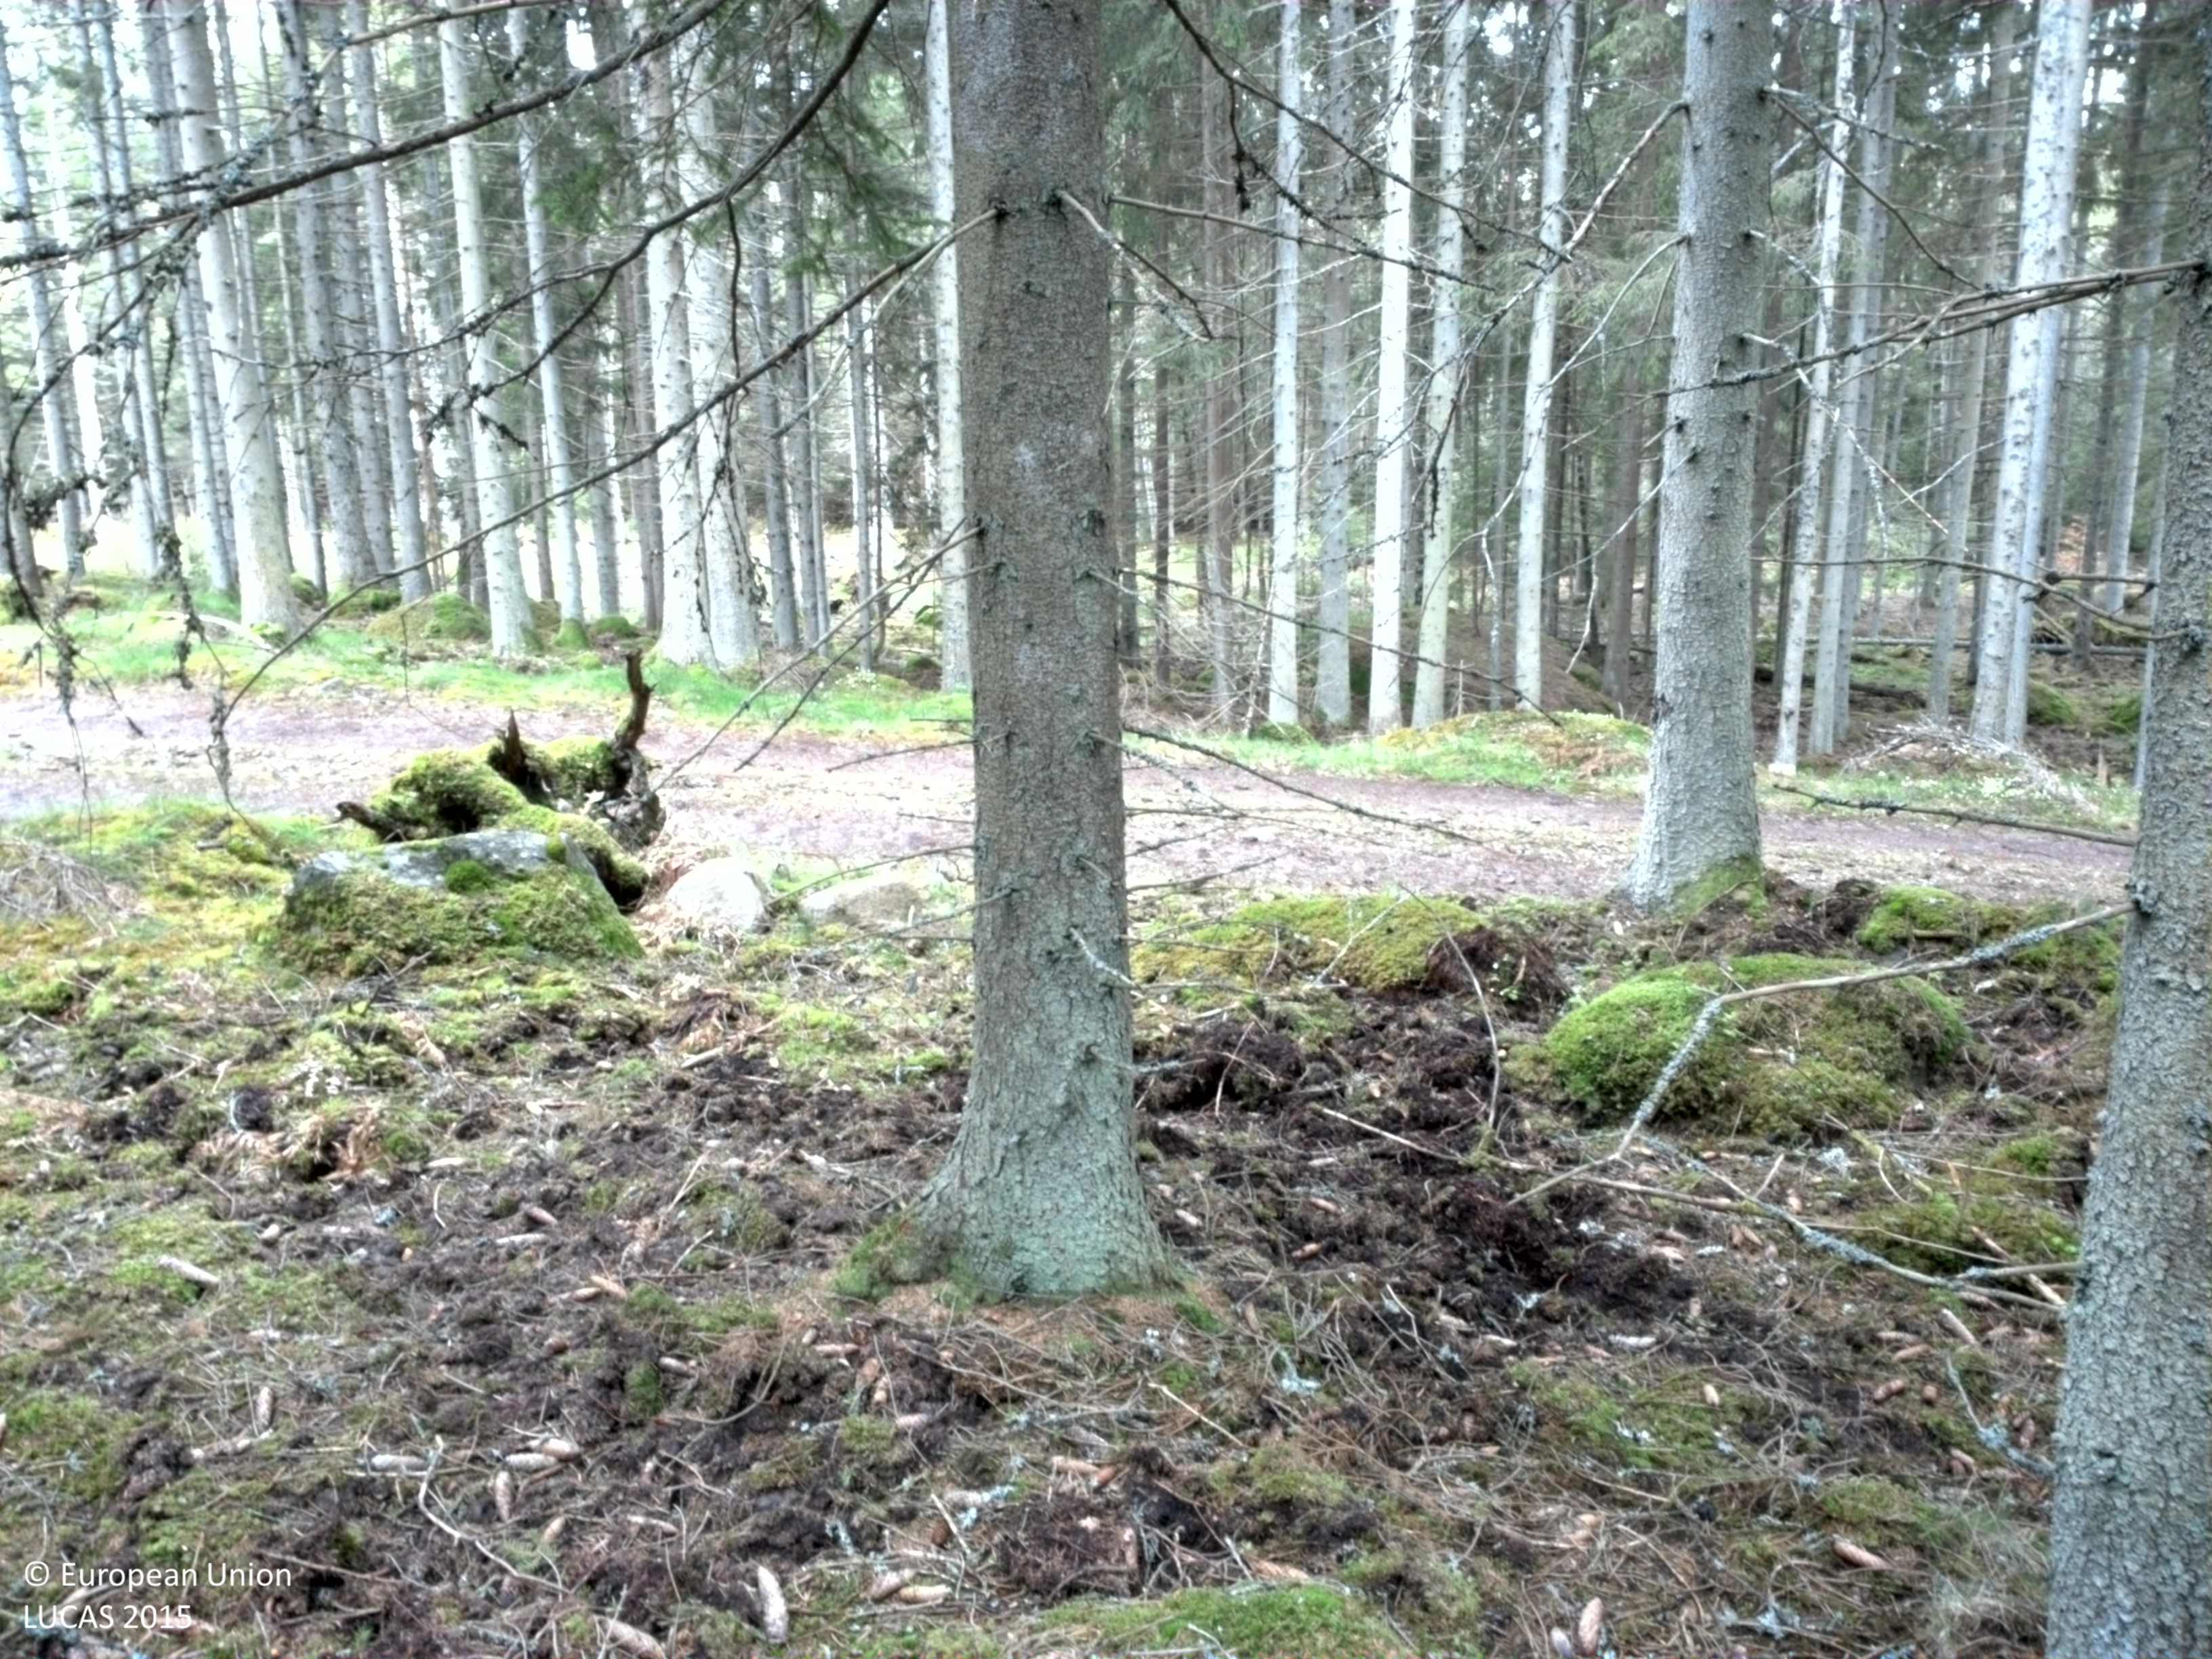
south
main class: Woodland
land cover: Spruce dominated coniferous woodland
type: boreal forest
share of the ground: > 75 %
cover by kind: coniferous forest trees 95 %, lichens and mosses 5 %
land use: Forestry
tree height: > 5 m
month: May
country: SE
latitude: 56.5036
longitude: 15.4741
